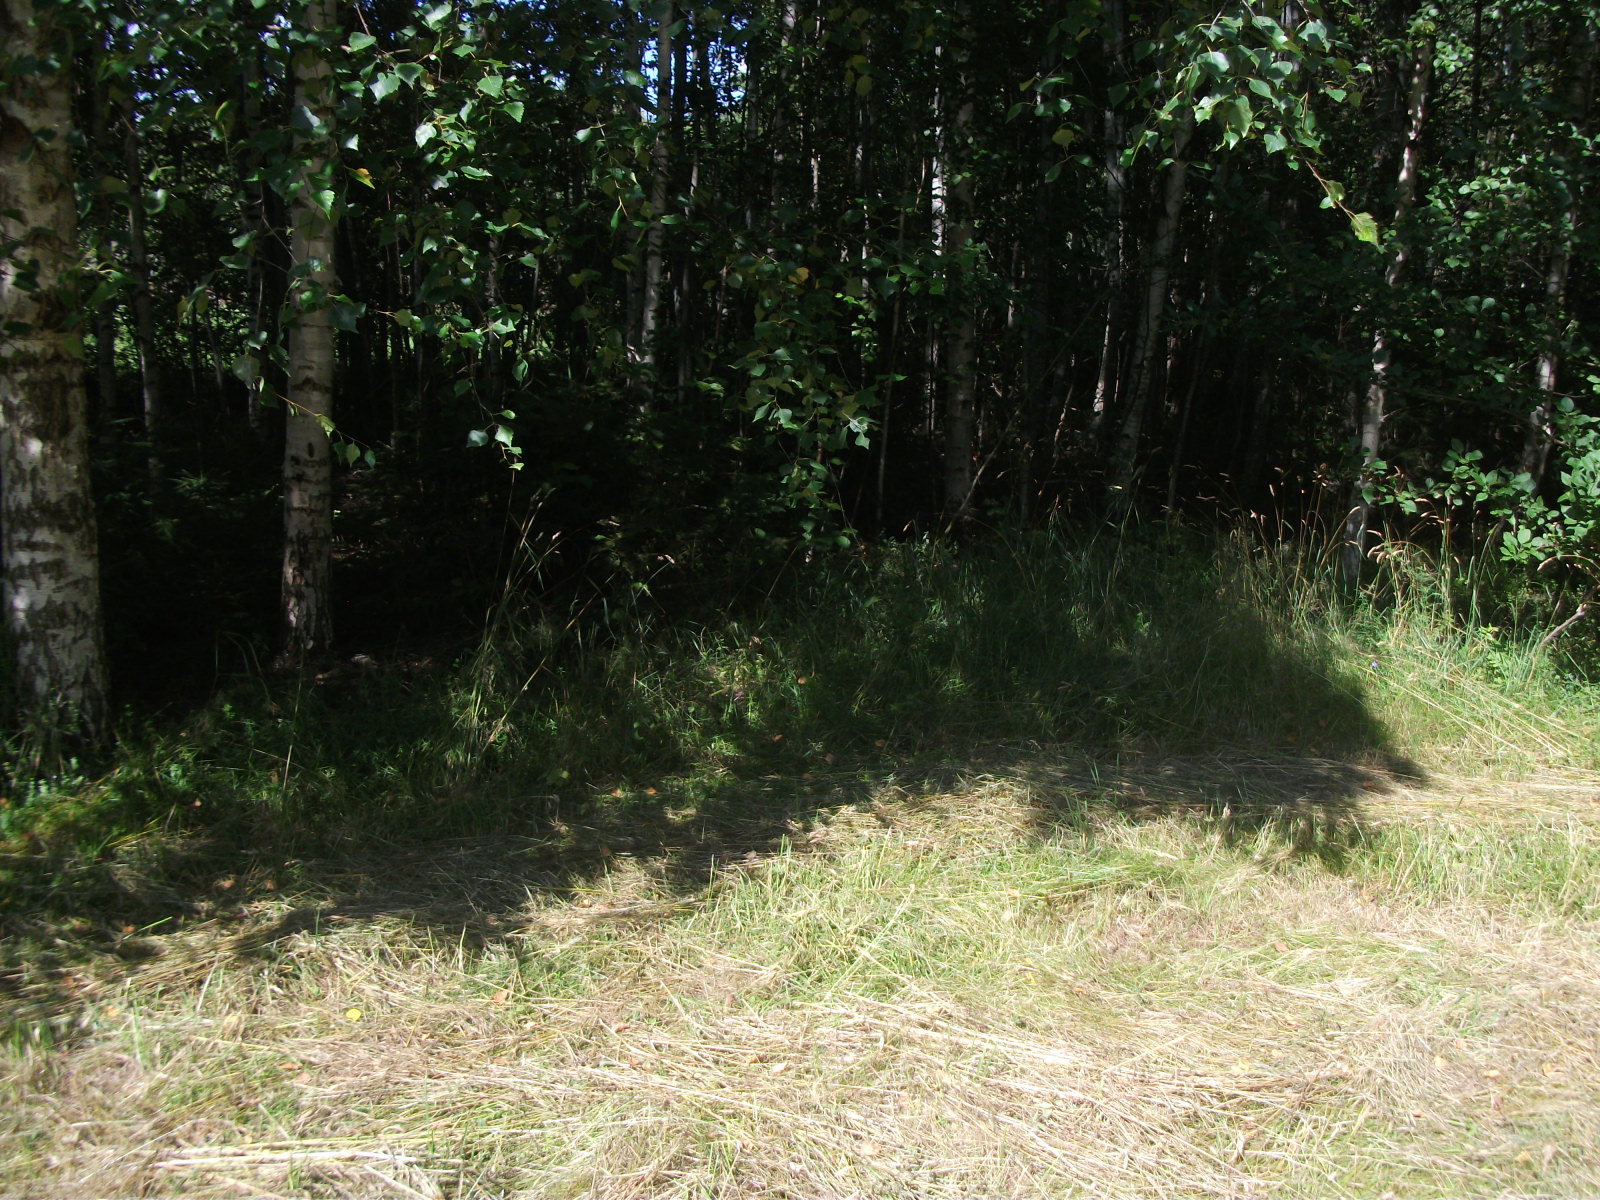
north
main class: Grassland
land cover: Grassland without tree/shrub cover
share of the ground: > 75 %
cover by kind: herbaceous plants 100 %
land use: Agriculture (excluding fallow land and kitchen gardens)
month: August
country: LV
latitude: 57.0930
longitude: 26.6703
